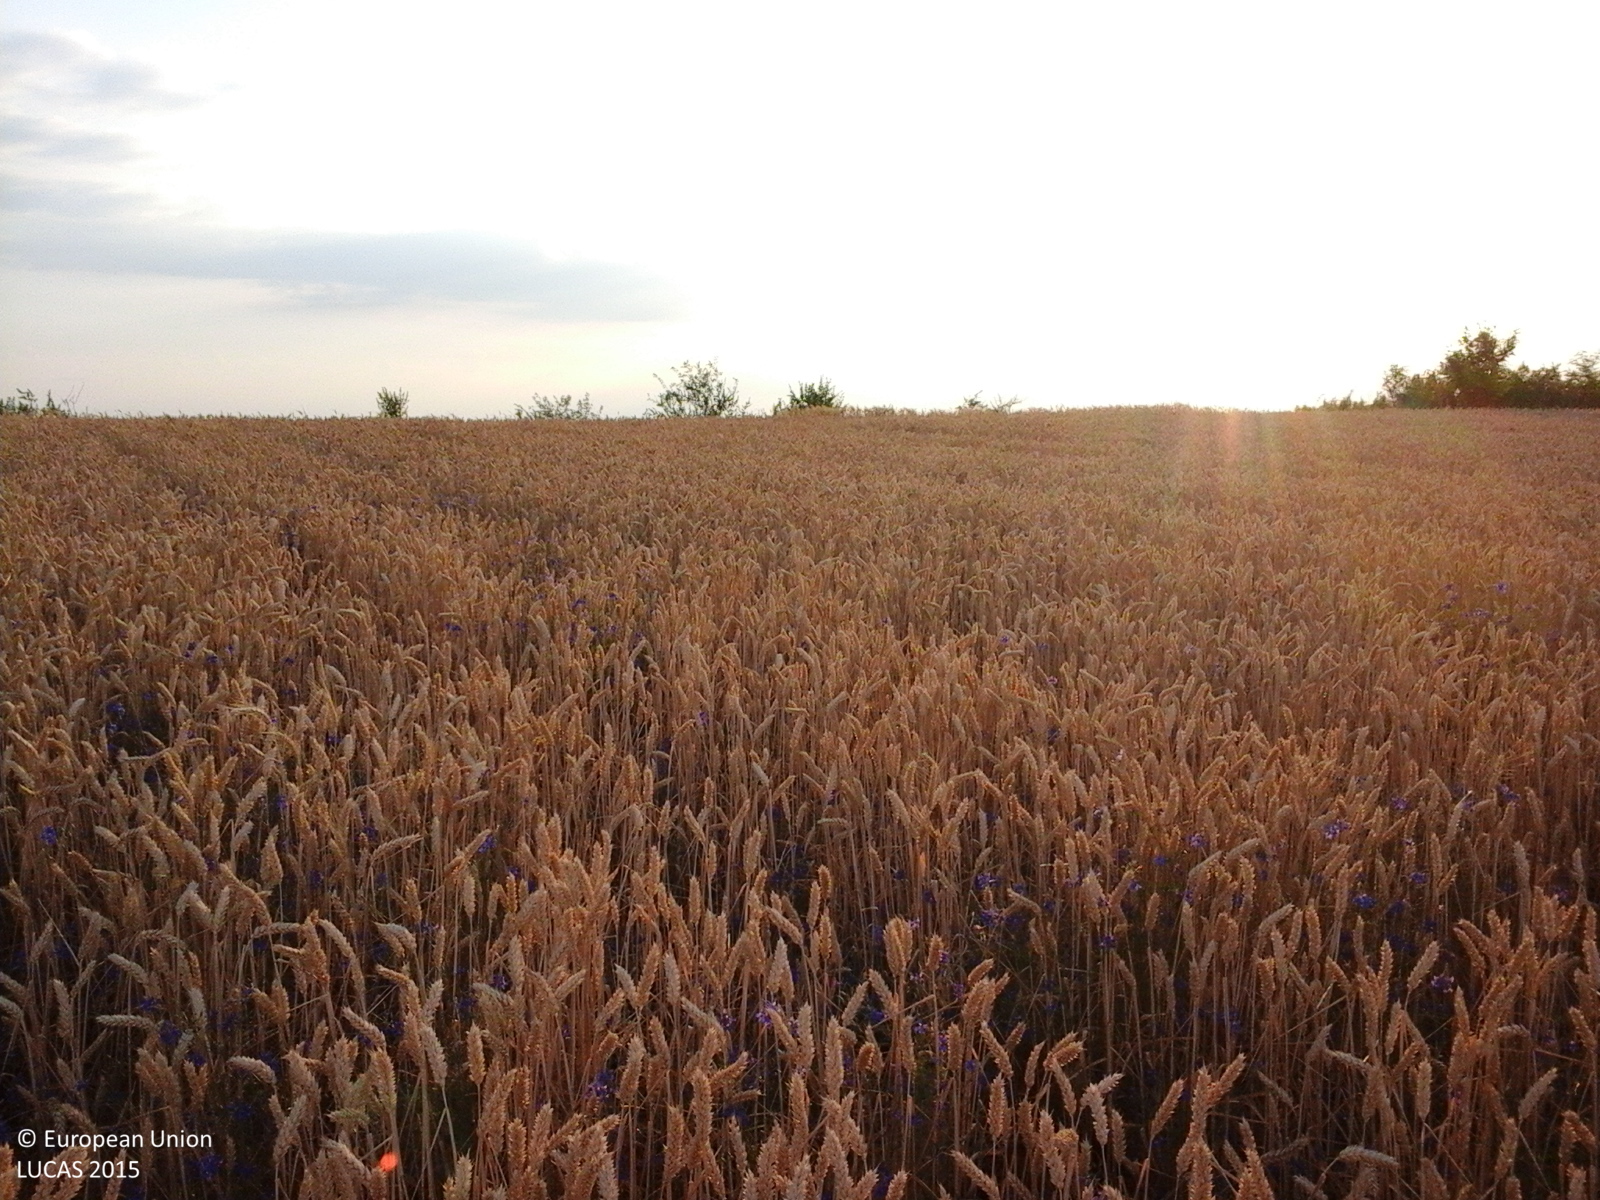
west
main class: Cropland
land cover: Common wheat
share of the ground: > 75 %
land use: Agriculture (excluding fallow land and kitchen gardens)
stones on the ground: < 10 %
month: June
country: RO
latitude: 47.1560
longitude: 27.4042
